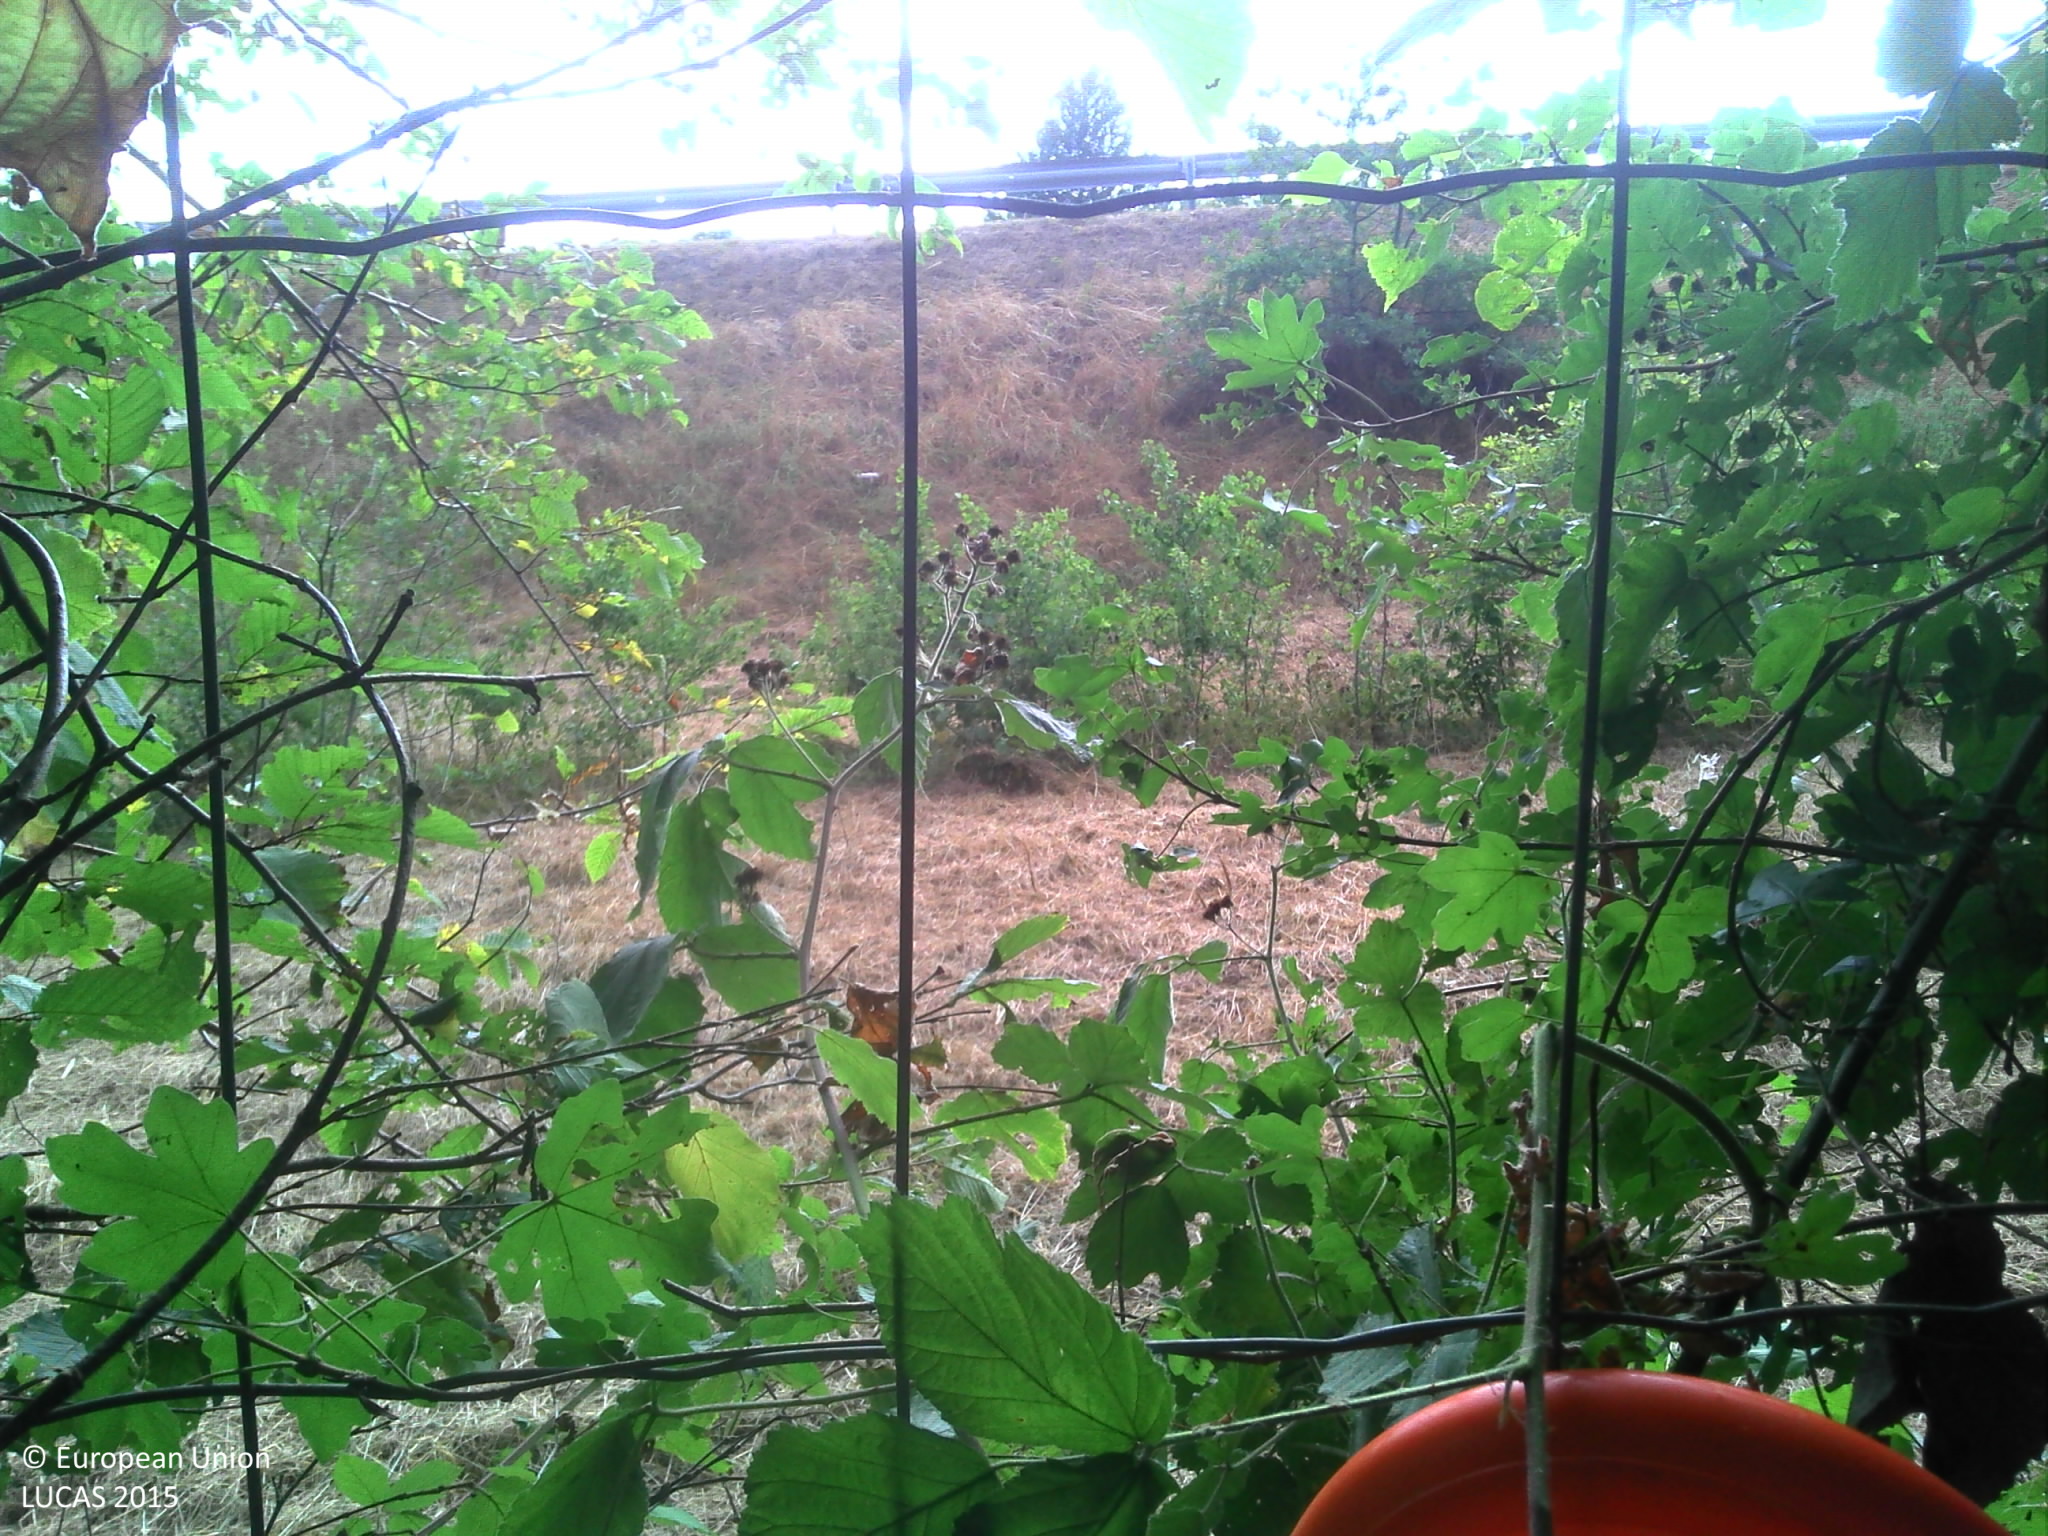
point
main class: Grassland
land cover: Spontaneously vegetated surfaces
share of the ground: > 75 %
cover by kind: herbaceous plants 100 %
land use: Road transport
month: July
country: FR
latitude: 46.8753
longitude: 4.8184
